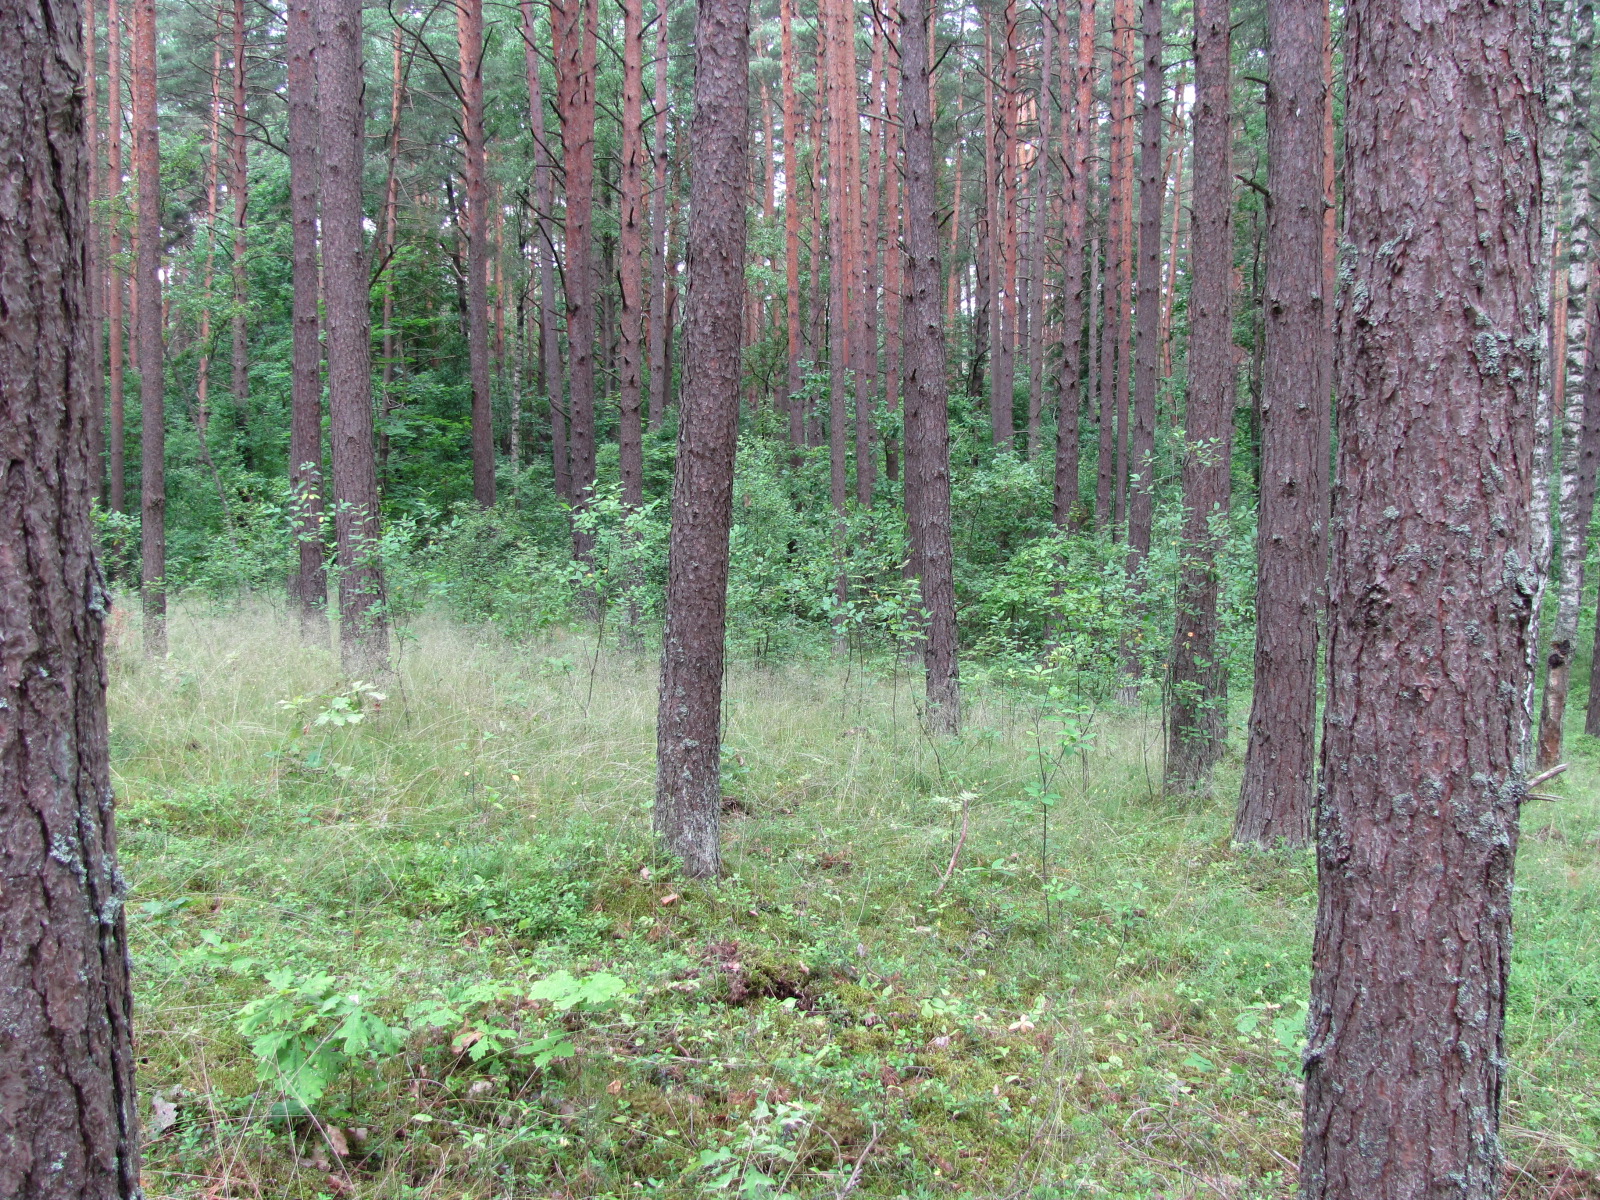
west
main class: Woodland
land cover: Pine dominated coniferous woodland
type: hemiboreal forest and nemoral coniferous forest and mixed broadleaved-coniferous forest
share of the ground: > 75 %
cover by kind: coniferous forest trees 80 %, shrubs 10 %, herbaceous plants 10 %
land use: Forestry
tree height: > 5 m
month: July
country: LV
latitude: 57.0626
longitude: 24.1520
